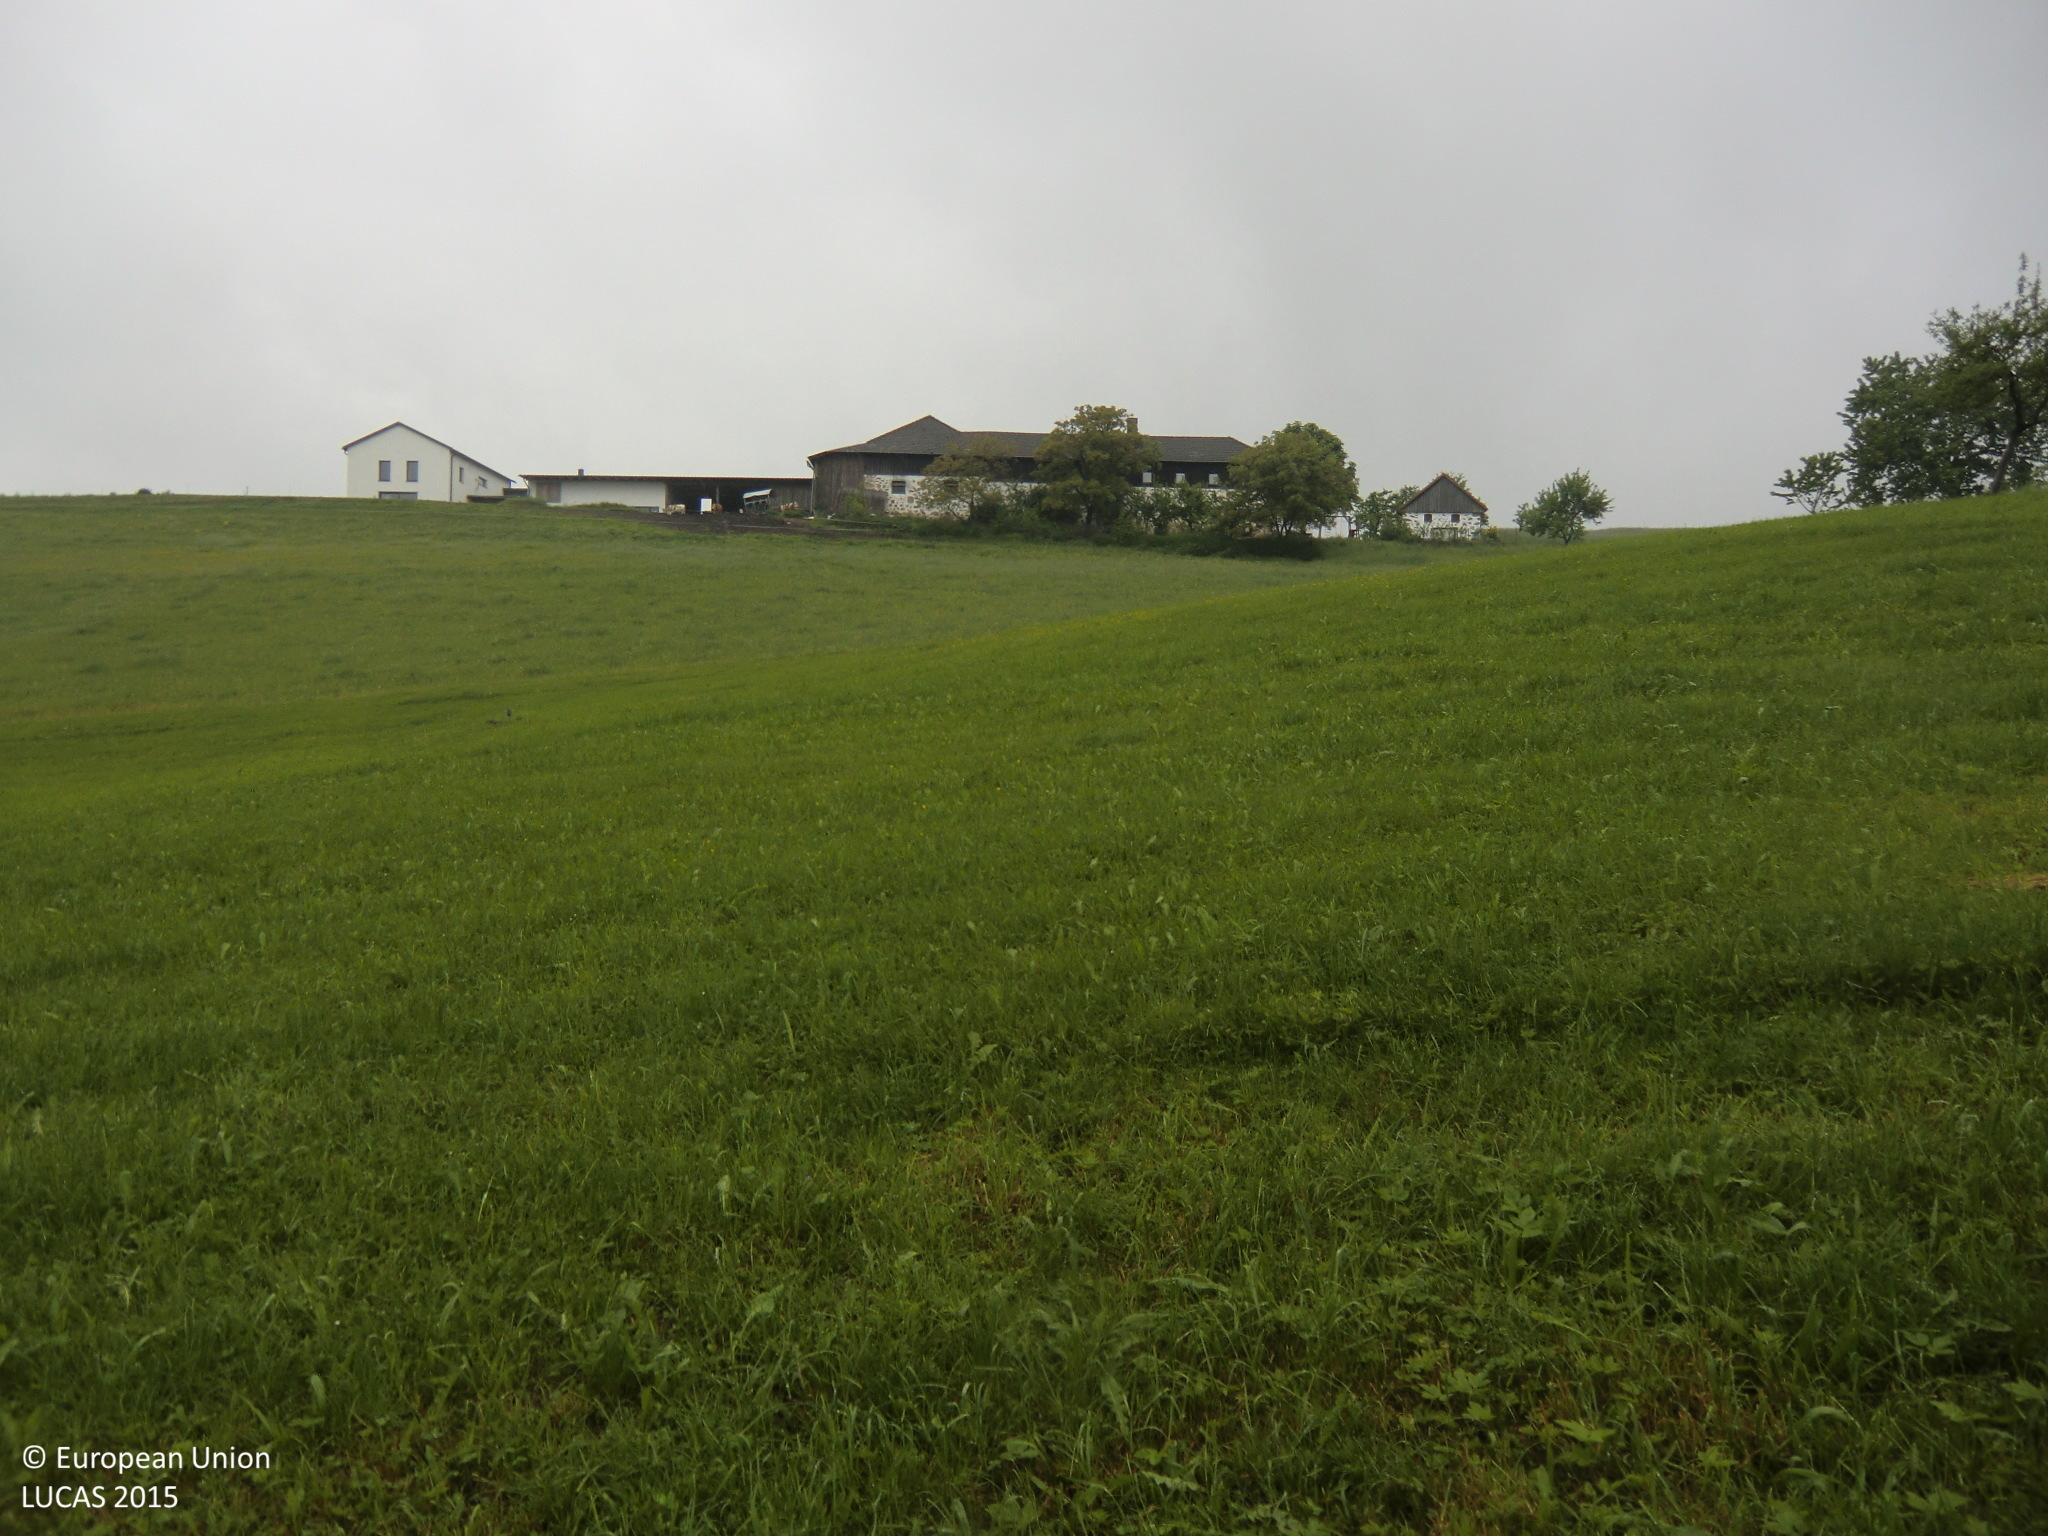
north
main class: Grassland
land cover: Grassland without tree/shrub cover
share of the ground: > 75 %
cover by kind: herbaceous plants 100 %
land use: Agriculture (excluding fallow land and kitchen gardens)
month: May
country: AT
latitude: 48.3988
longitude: 14.5795
